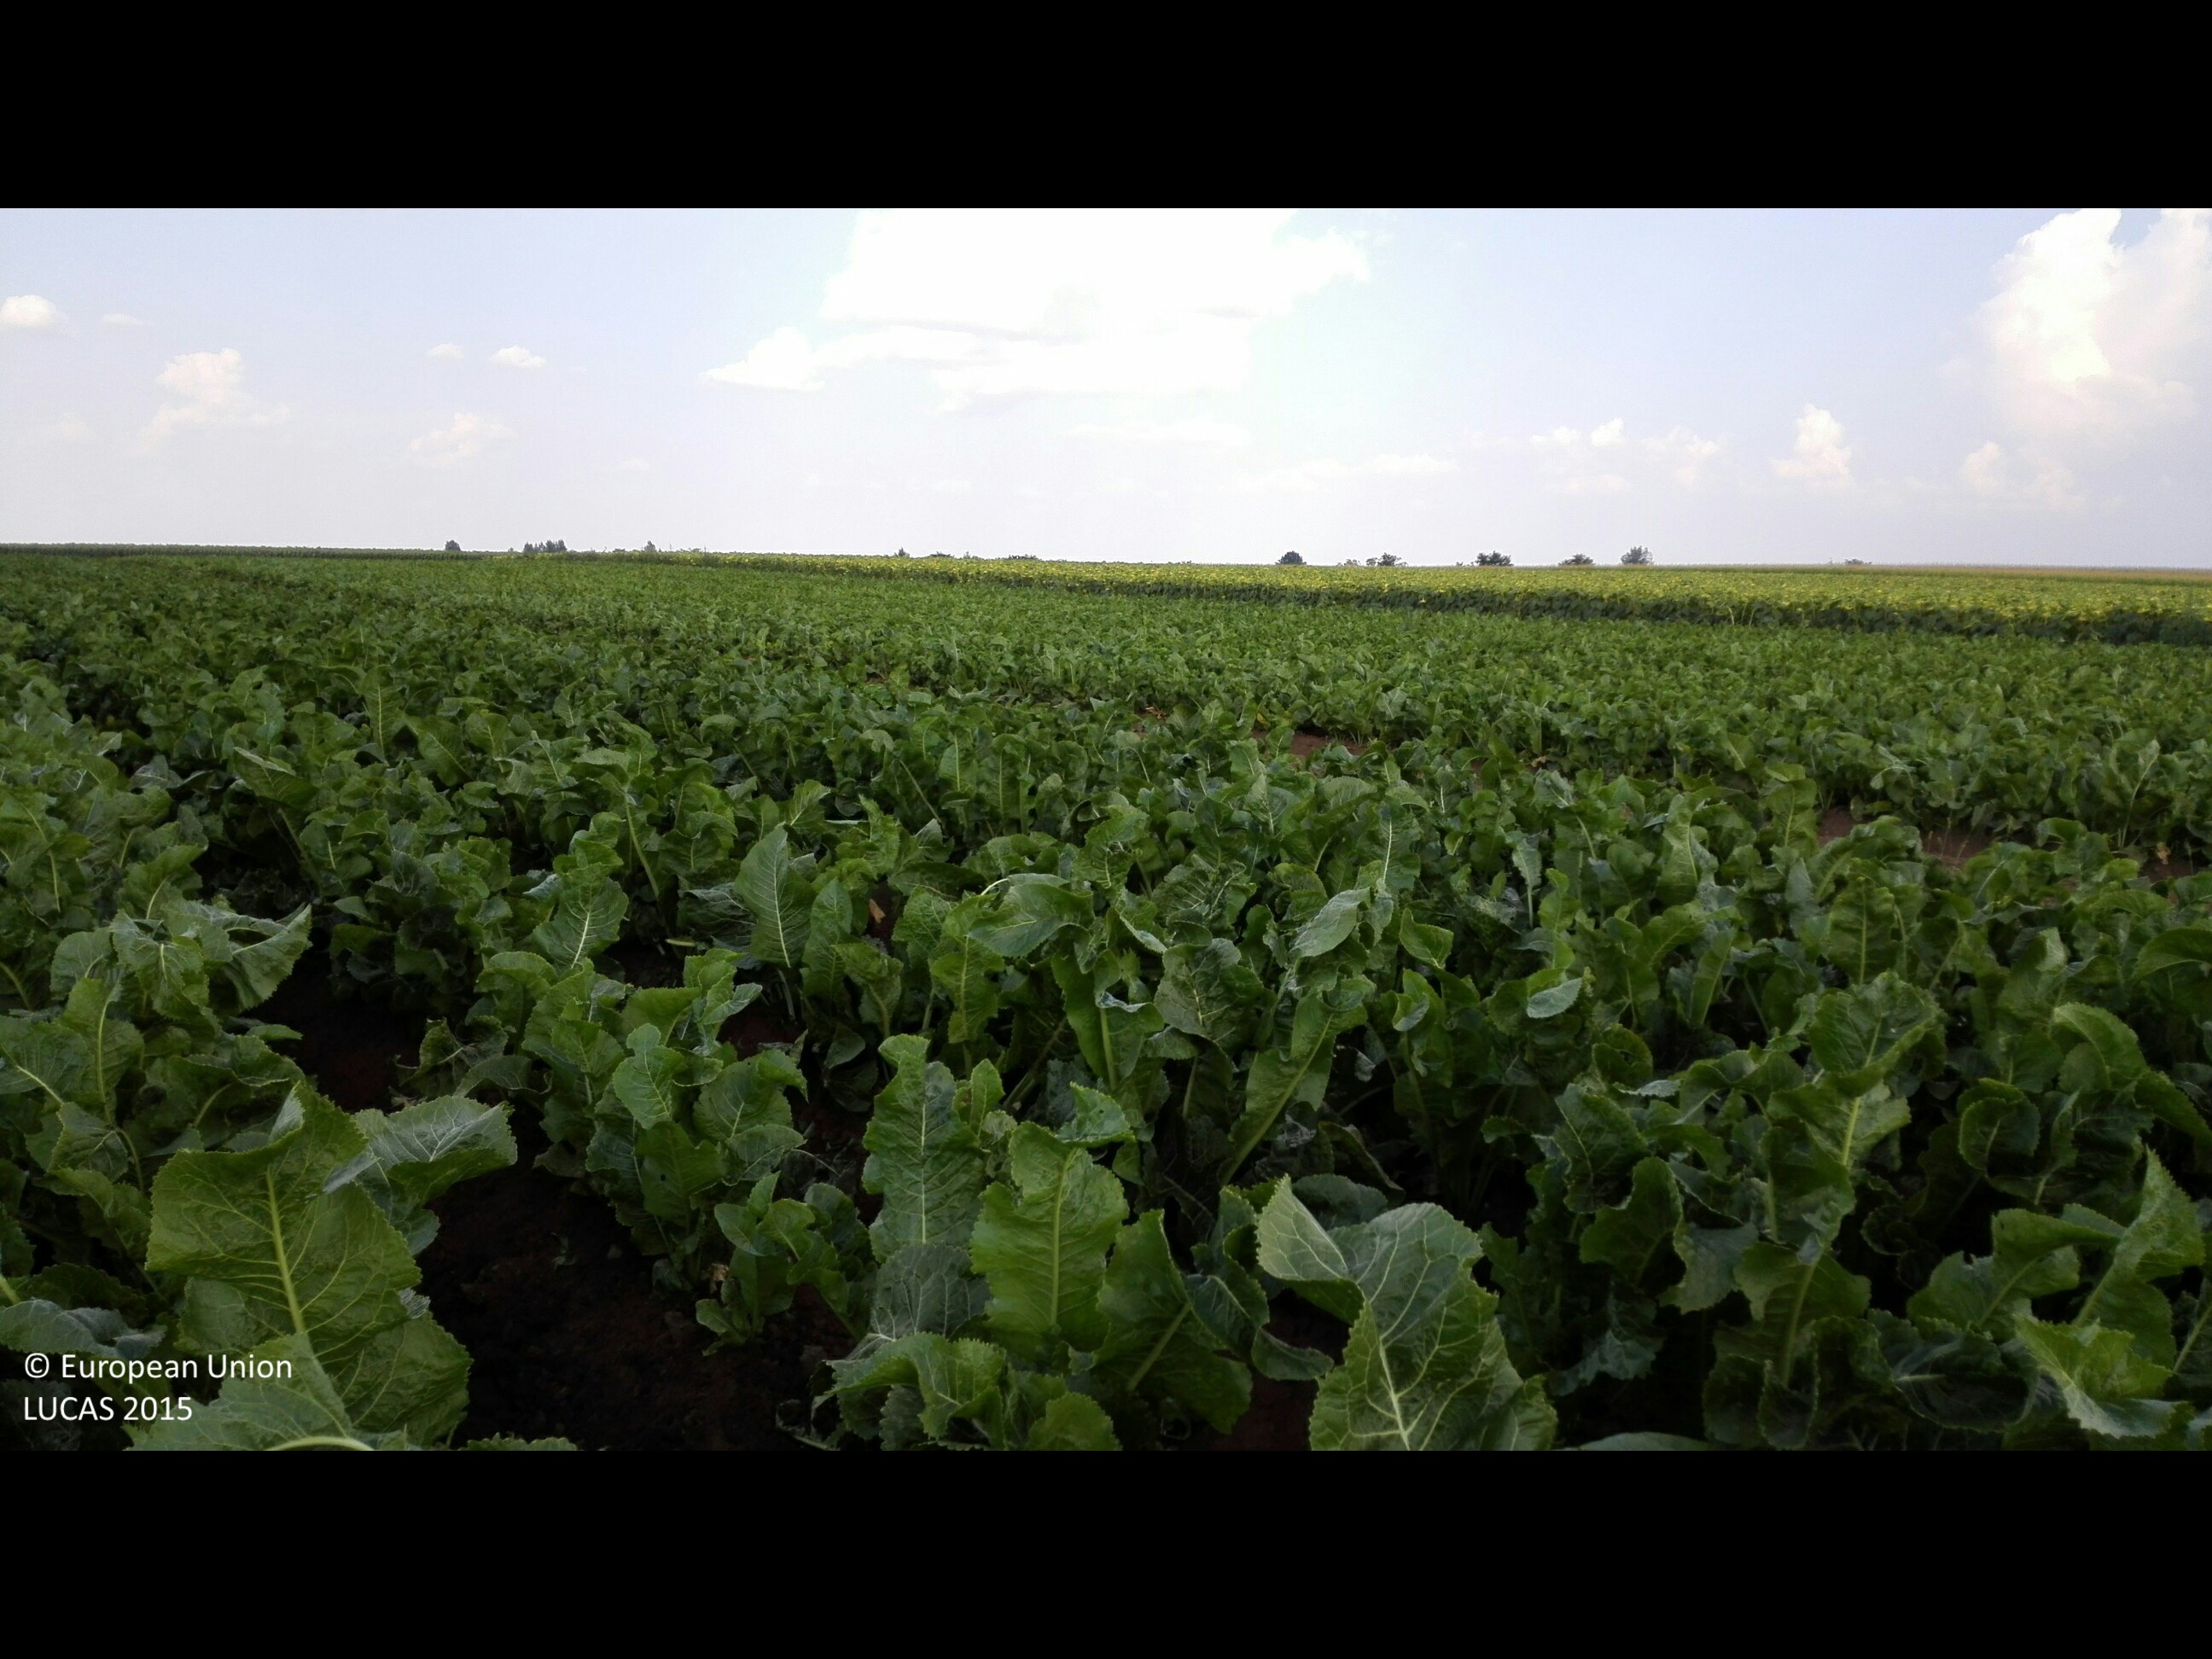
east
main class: Cropland
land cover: Other root crops
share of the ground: > 75 %
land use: Agriculture (excluding fallow land and kitchen gardens)
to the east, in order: Other root crops; Sunflower; Grass margins; Ditches and canals; Grass margins; Paved roads, cycling and walking lanes; Grass margins; Ditches and canals; Grass margins; Sunflower
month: August
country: HU
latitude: 47.4029
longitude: 21.9880
